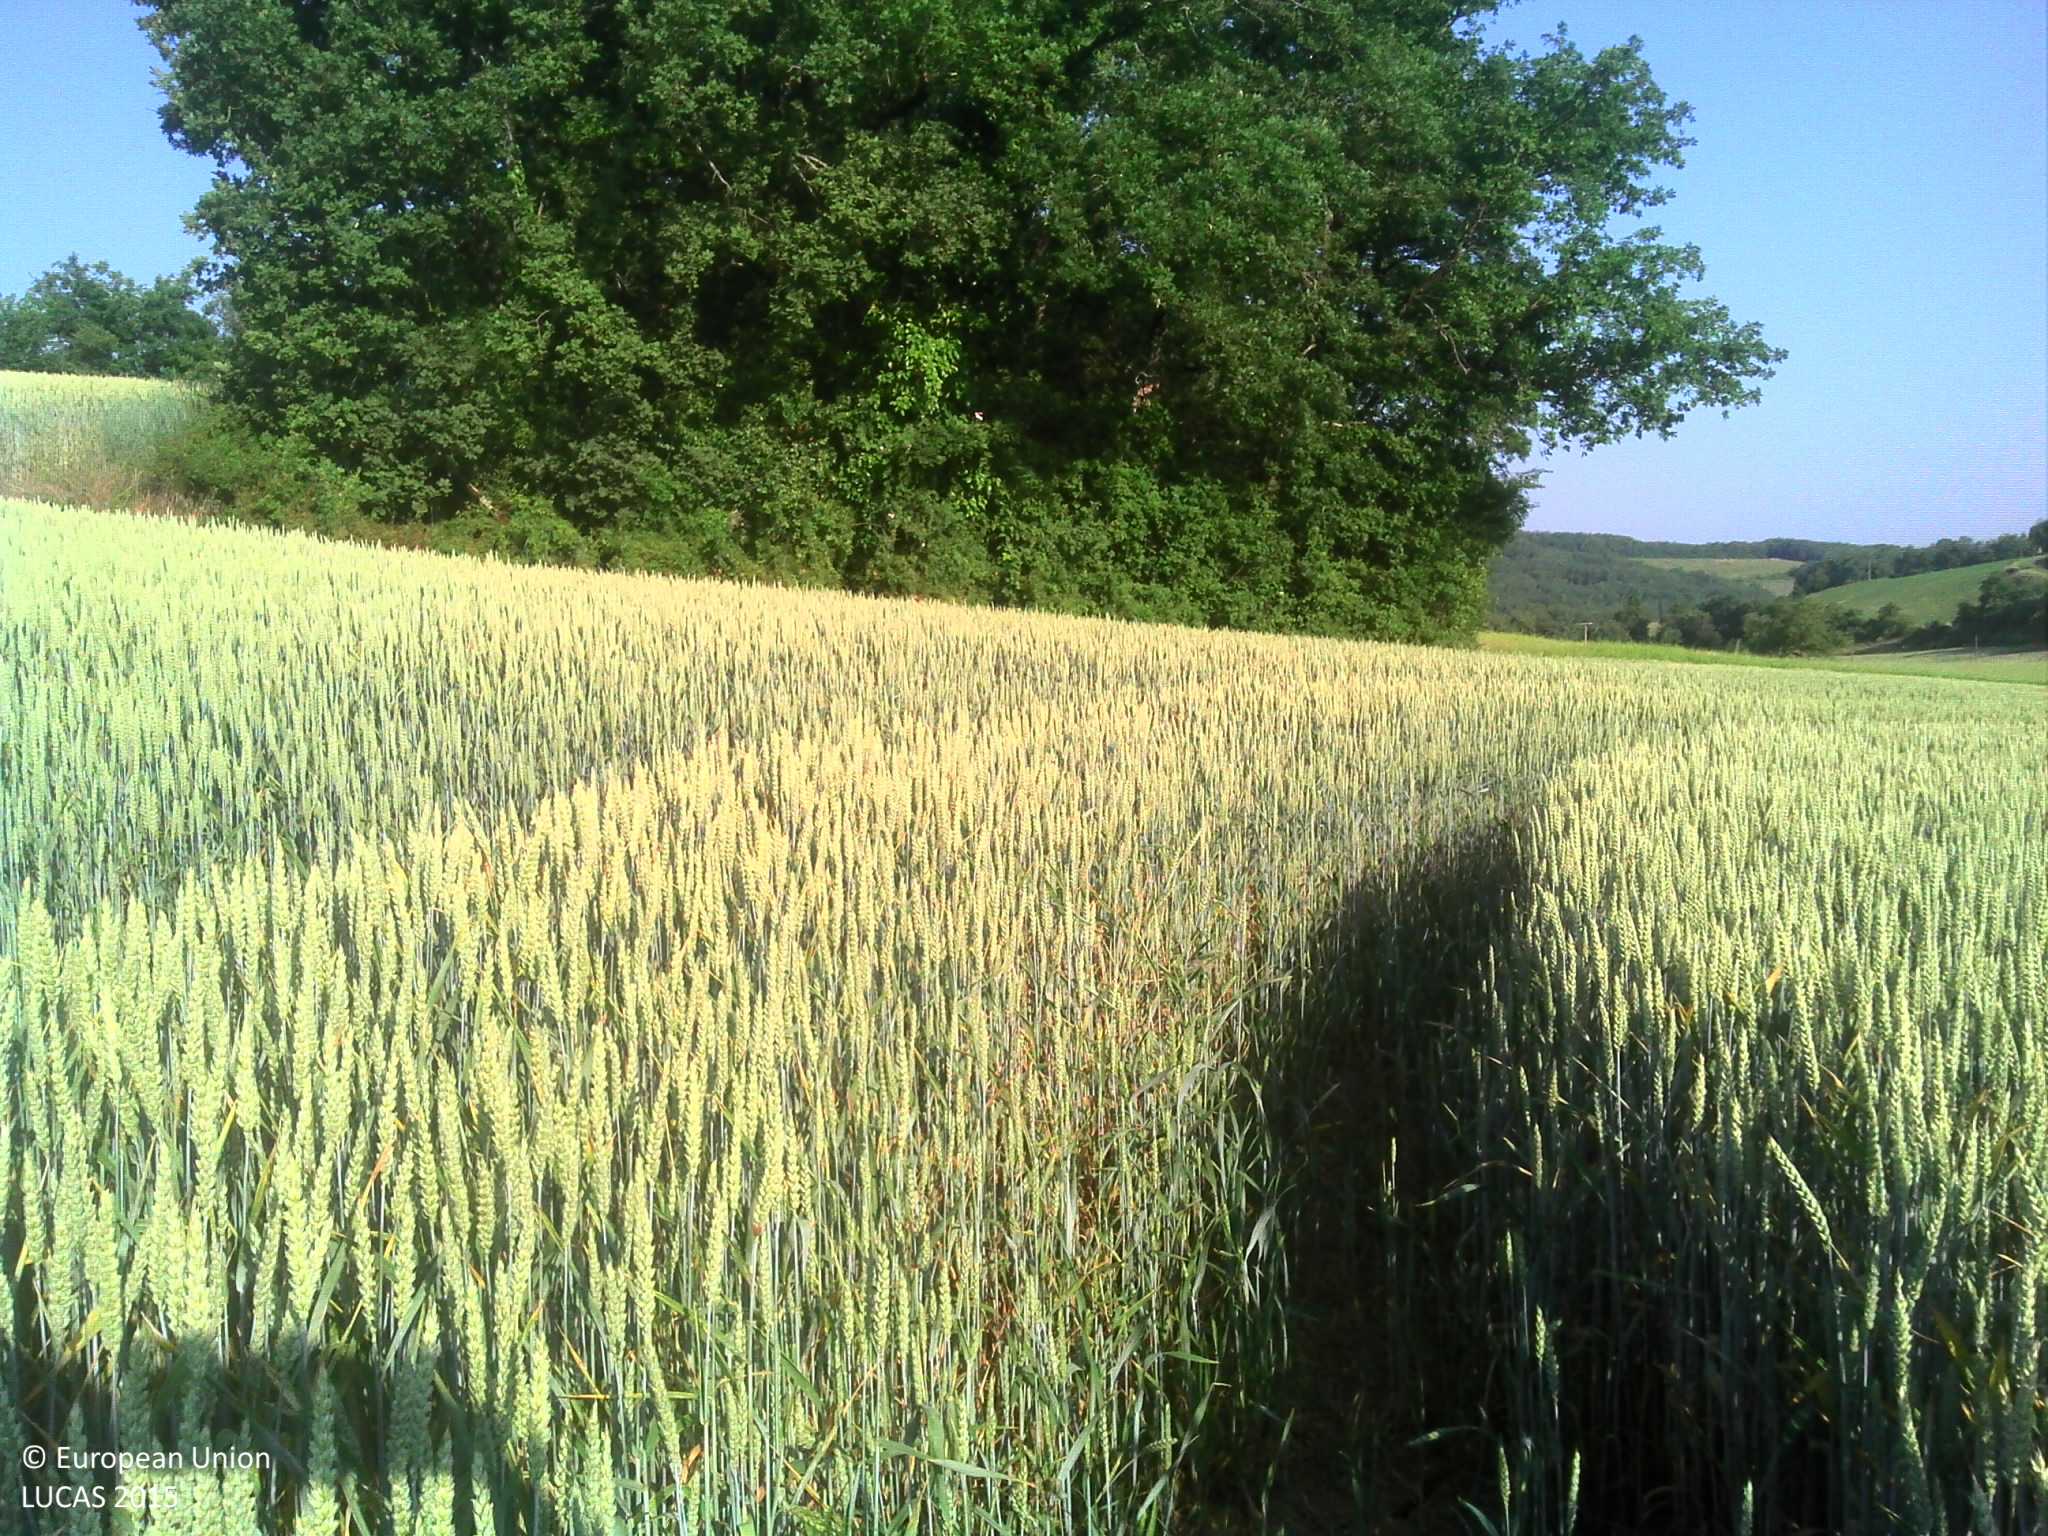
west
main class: Cropland
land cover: Common wheat
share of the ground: > 75 %
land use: Agriculture (excluding fallow land and kitchen gardens)
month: June
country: FR
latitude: 43.8860
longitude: 2.1000
